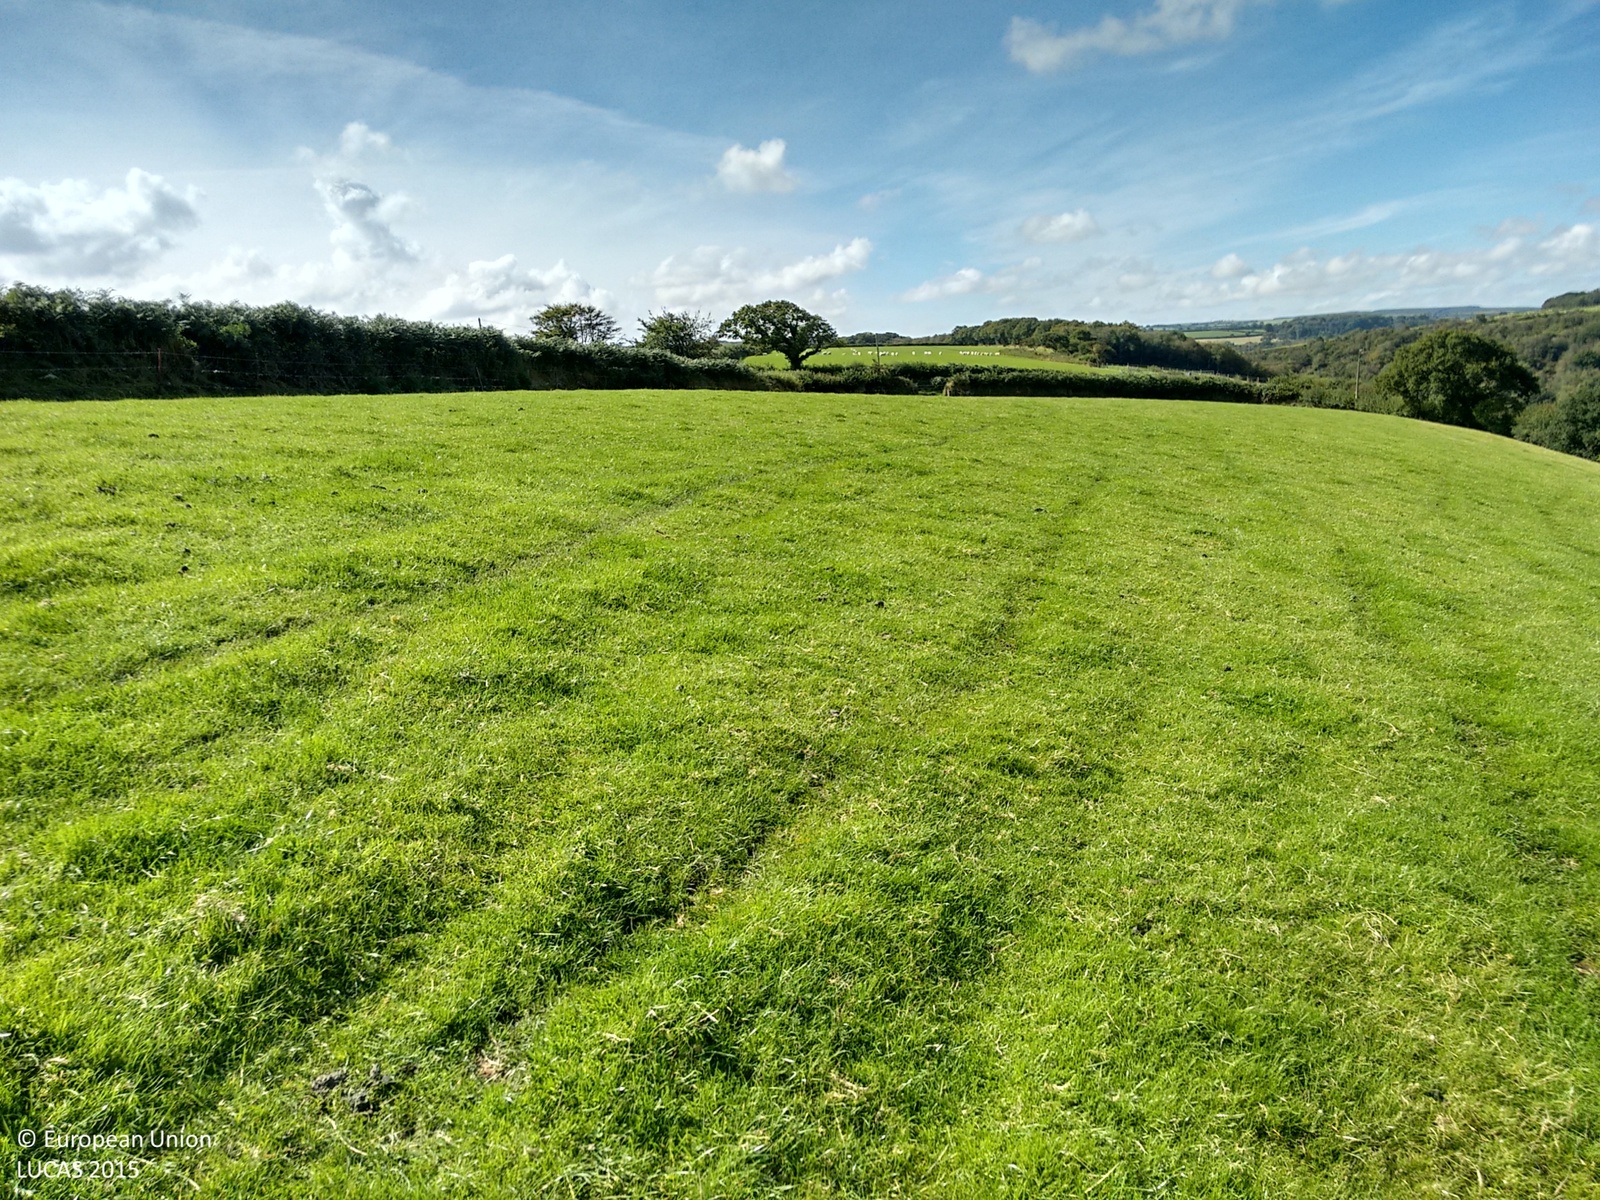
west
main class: Grassland
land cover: Grassland without tree/shrub cover
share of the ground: > 75 %
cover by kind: herbaceous plants 100 %
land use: Agriculture (excluding fallow land and kitchen gardens)
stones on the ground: < 10 %
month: September
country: GB
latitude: 50.6452
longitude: -4.4577
